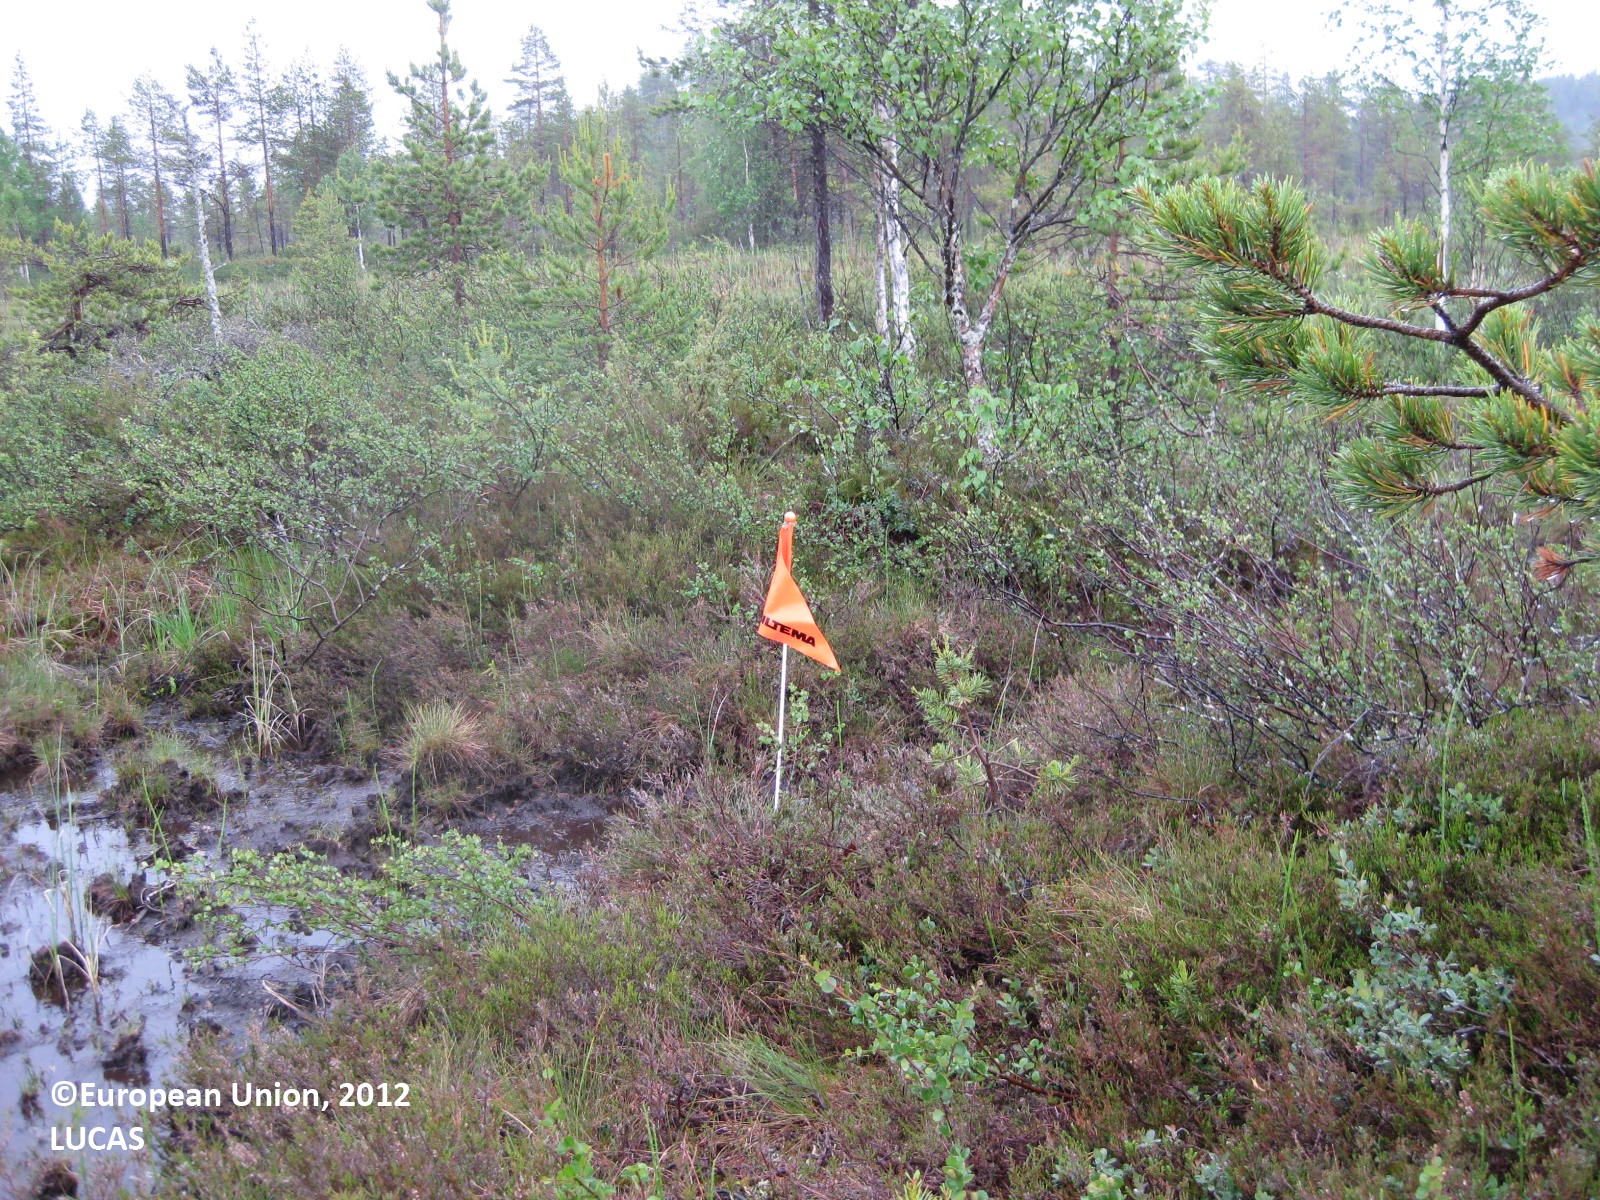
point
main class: Woodland
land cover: Pine dominated mixed woodland
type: boreal forest
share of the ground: 10 - 25 %
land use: Semi-natural and natural areas not in use
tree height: > 5 m
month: July
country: FI
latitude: 65.6702
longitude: 29.4448
